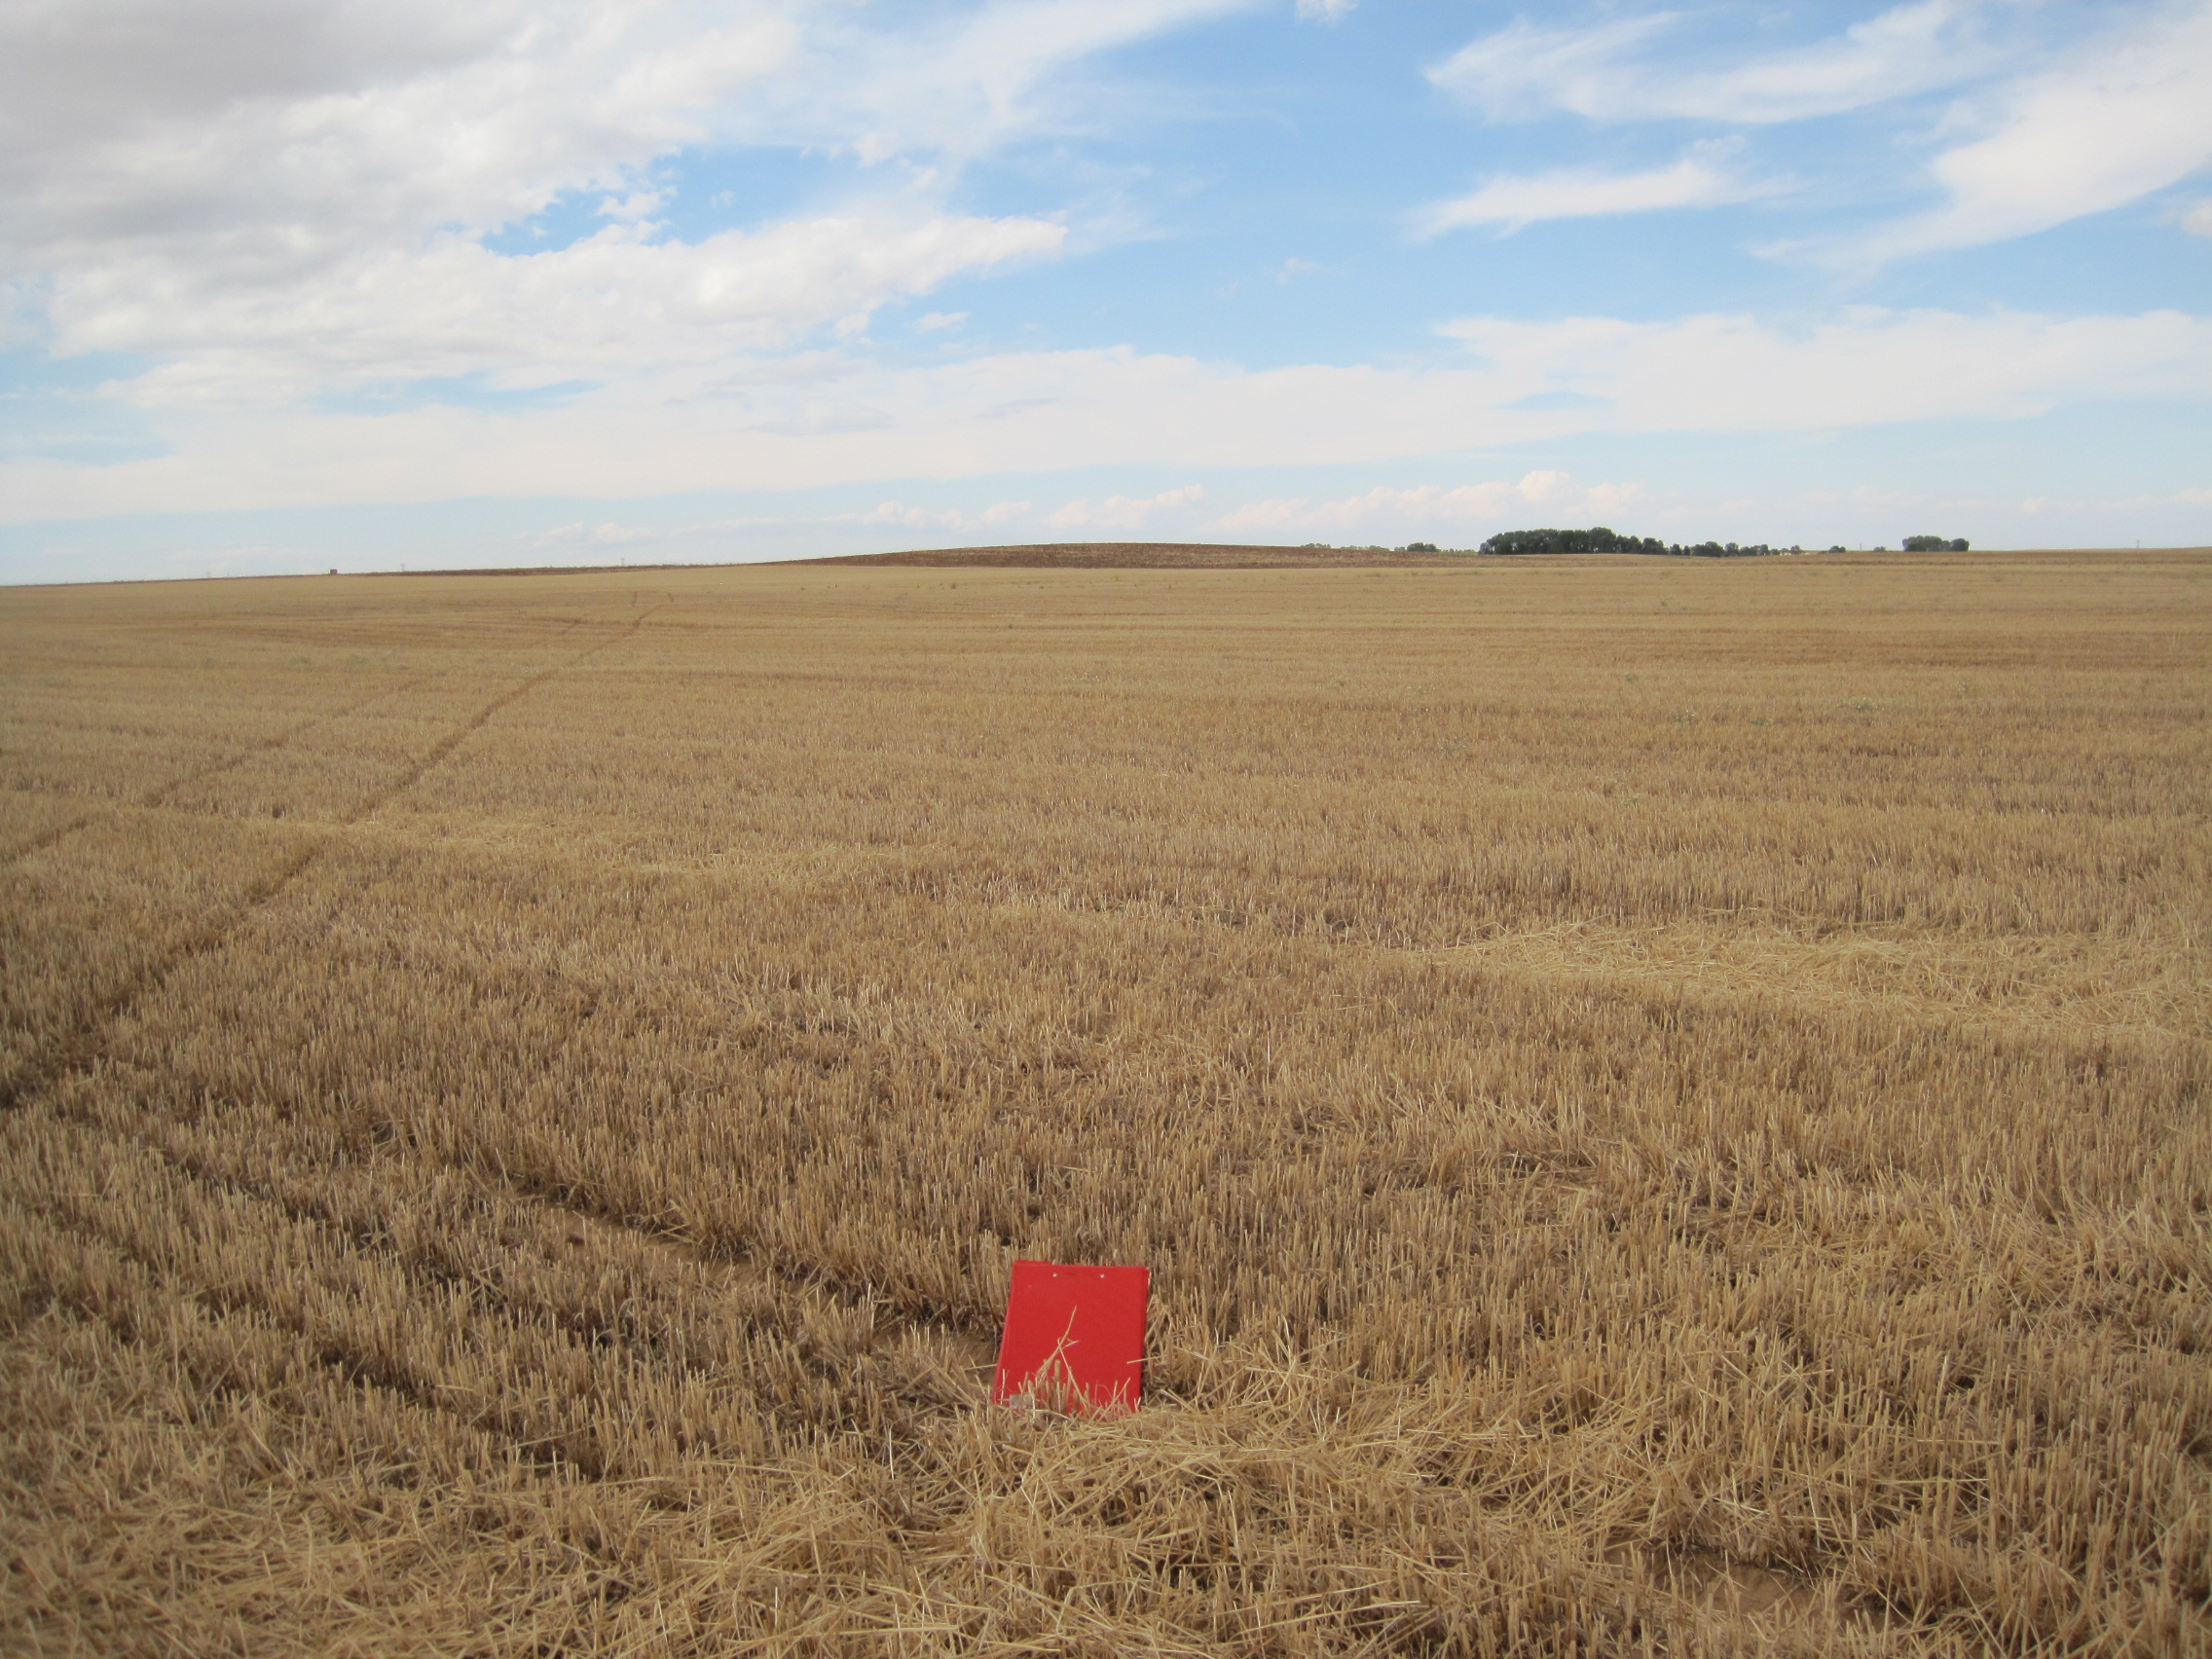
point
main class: Cropland
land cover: Barley
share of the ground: < 10 %
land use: Agriculture (excluding fallow land and kitchen gardens)
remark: Harvested field
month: July
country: ES
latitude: 41.8890
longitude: -5.5256
